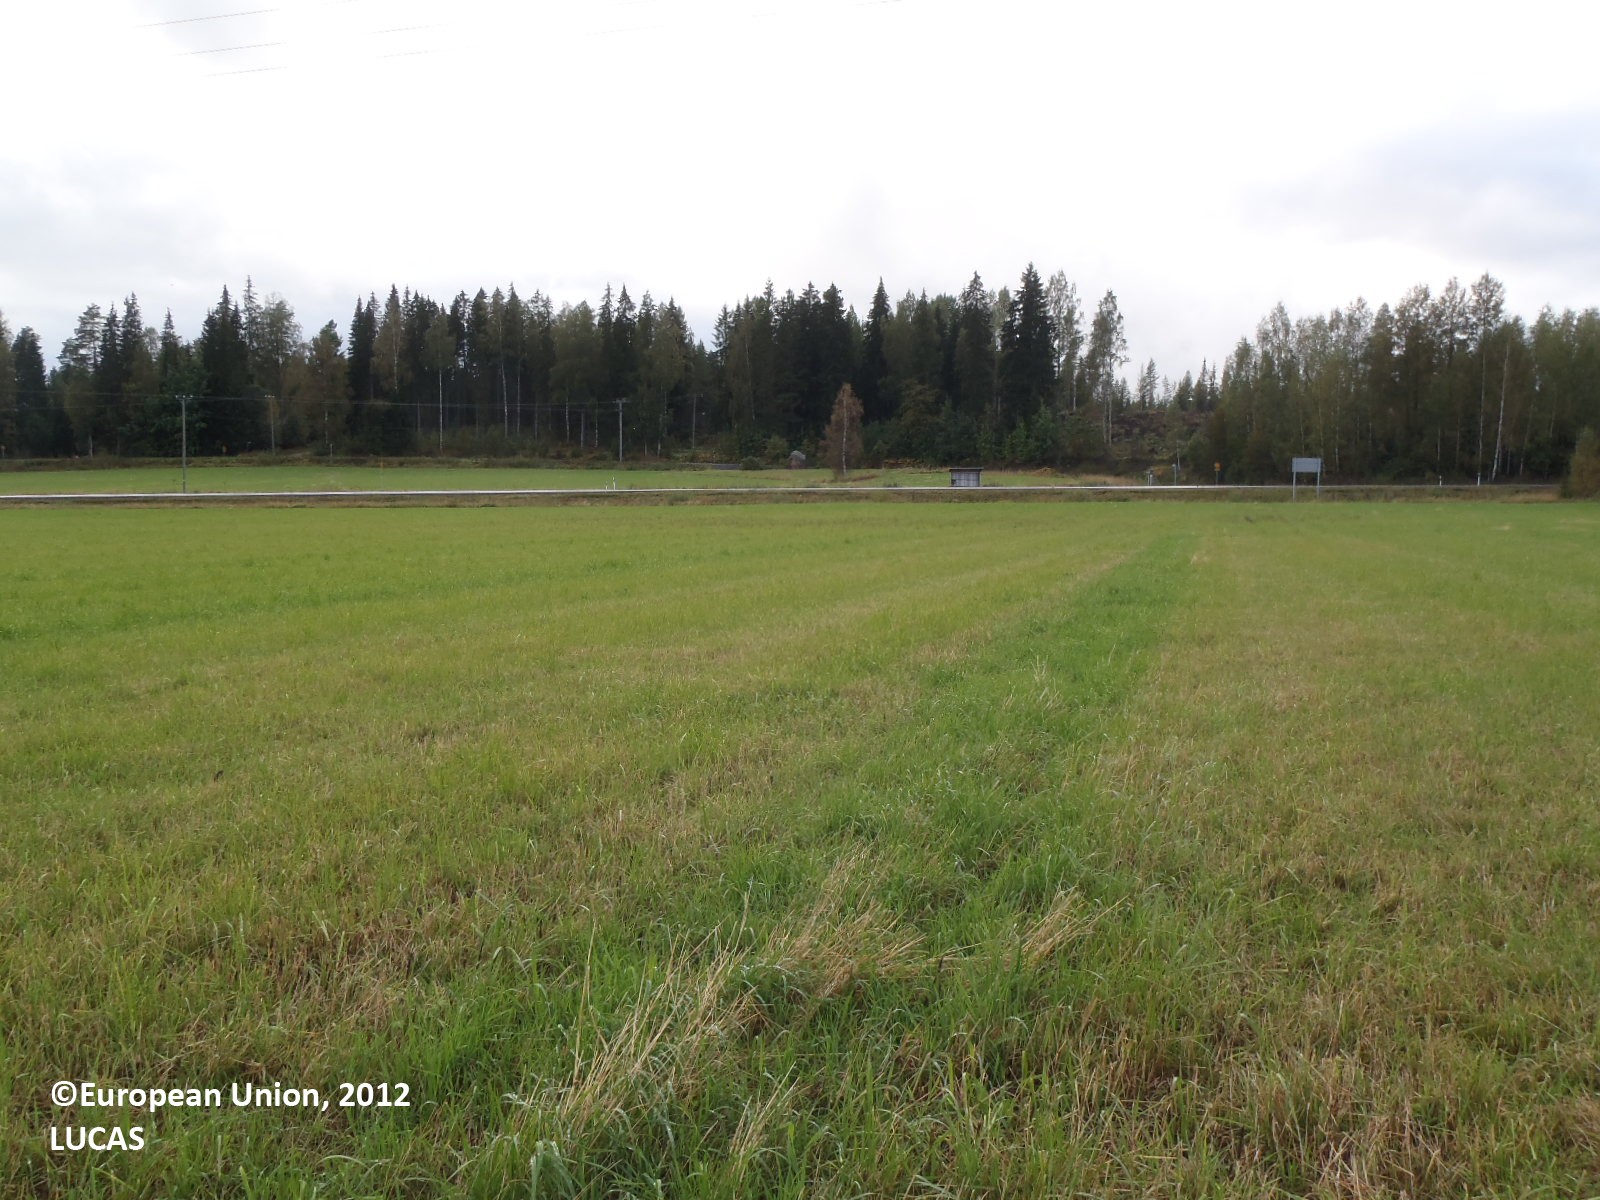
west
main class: Cropland
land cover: Temporary grasslands
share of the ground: > 75 %
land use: Agriculture (excluding fallow land and kitchen gardens)
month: September
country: FI
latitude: 61.6820
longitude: 22.5539
